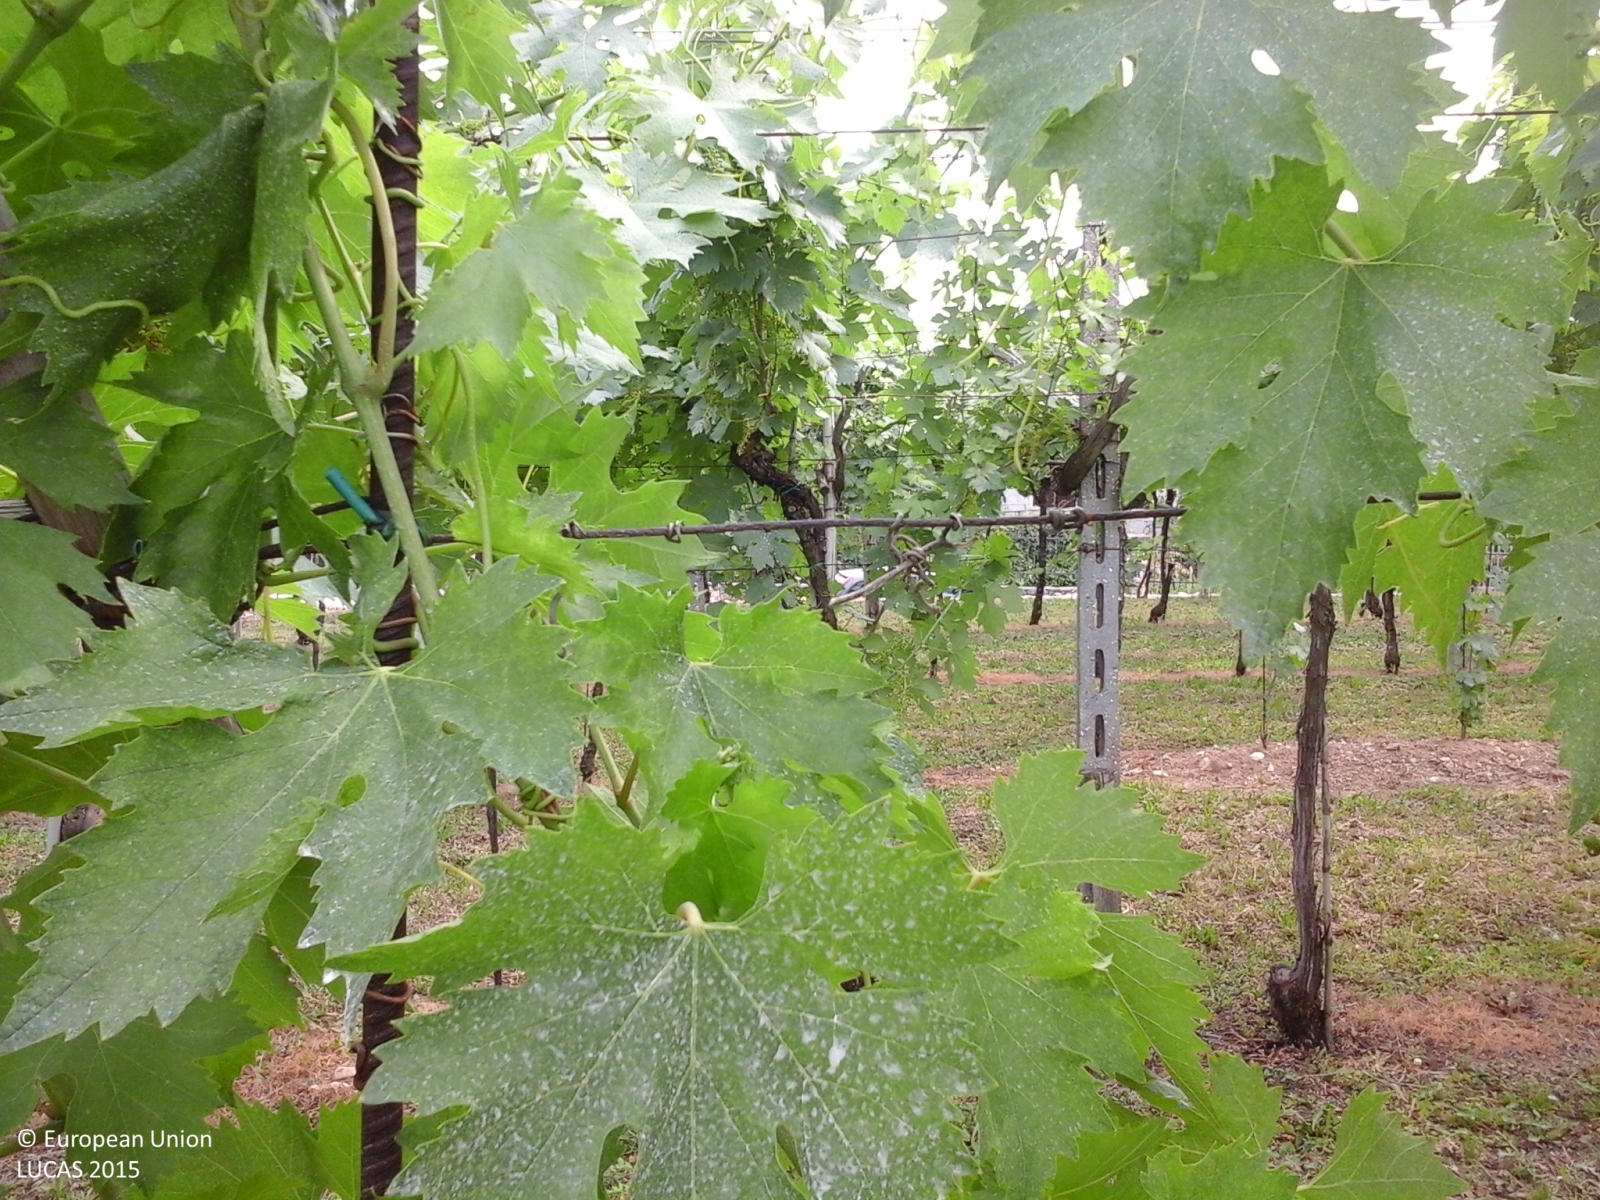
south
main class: Cropland
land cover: Vineyards
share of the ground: > 75 %
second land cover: Grassland without tree/shrub cover
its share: > 75 %
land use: Agriculture (excluding fallow land and kitchen gardens)
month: June
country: IT
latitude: 45.5363
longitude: 10.9333
